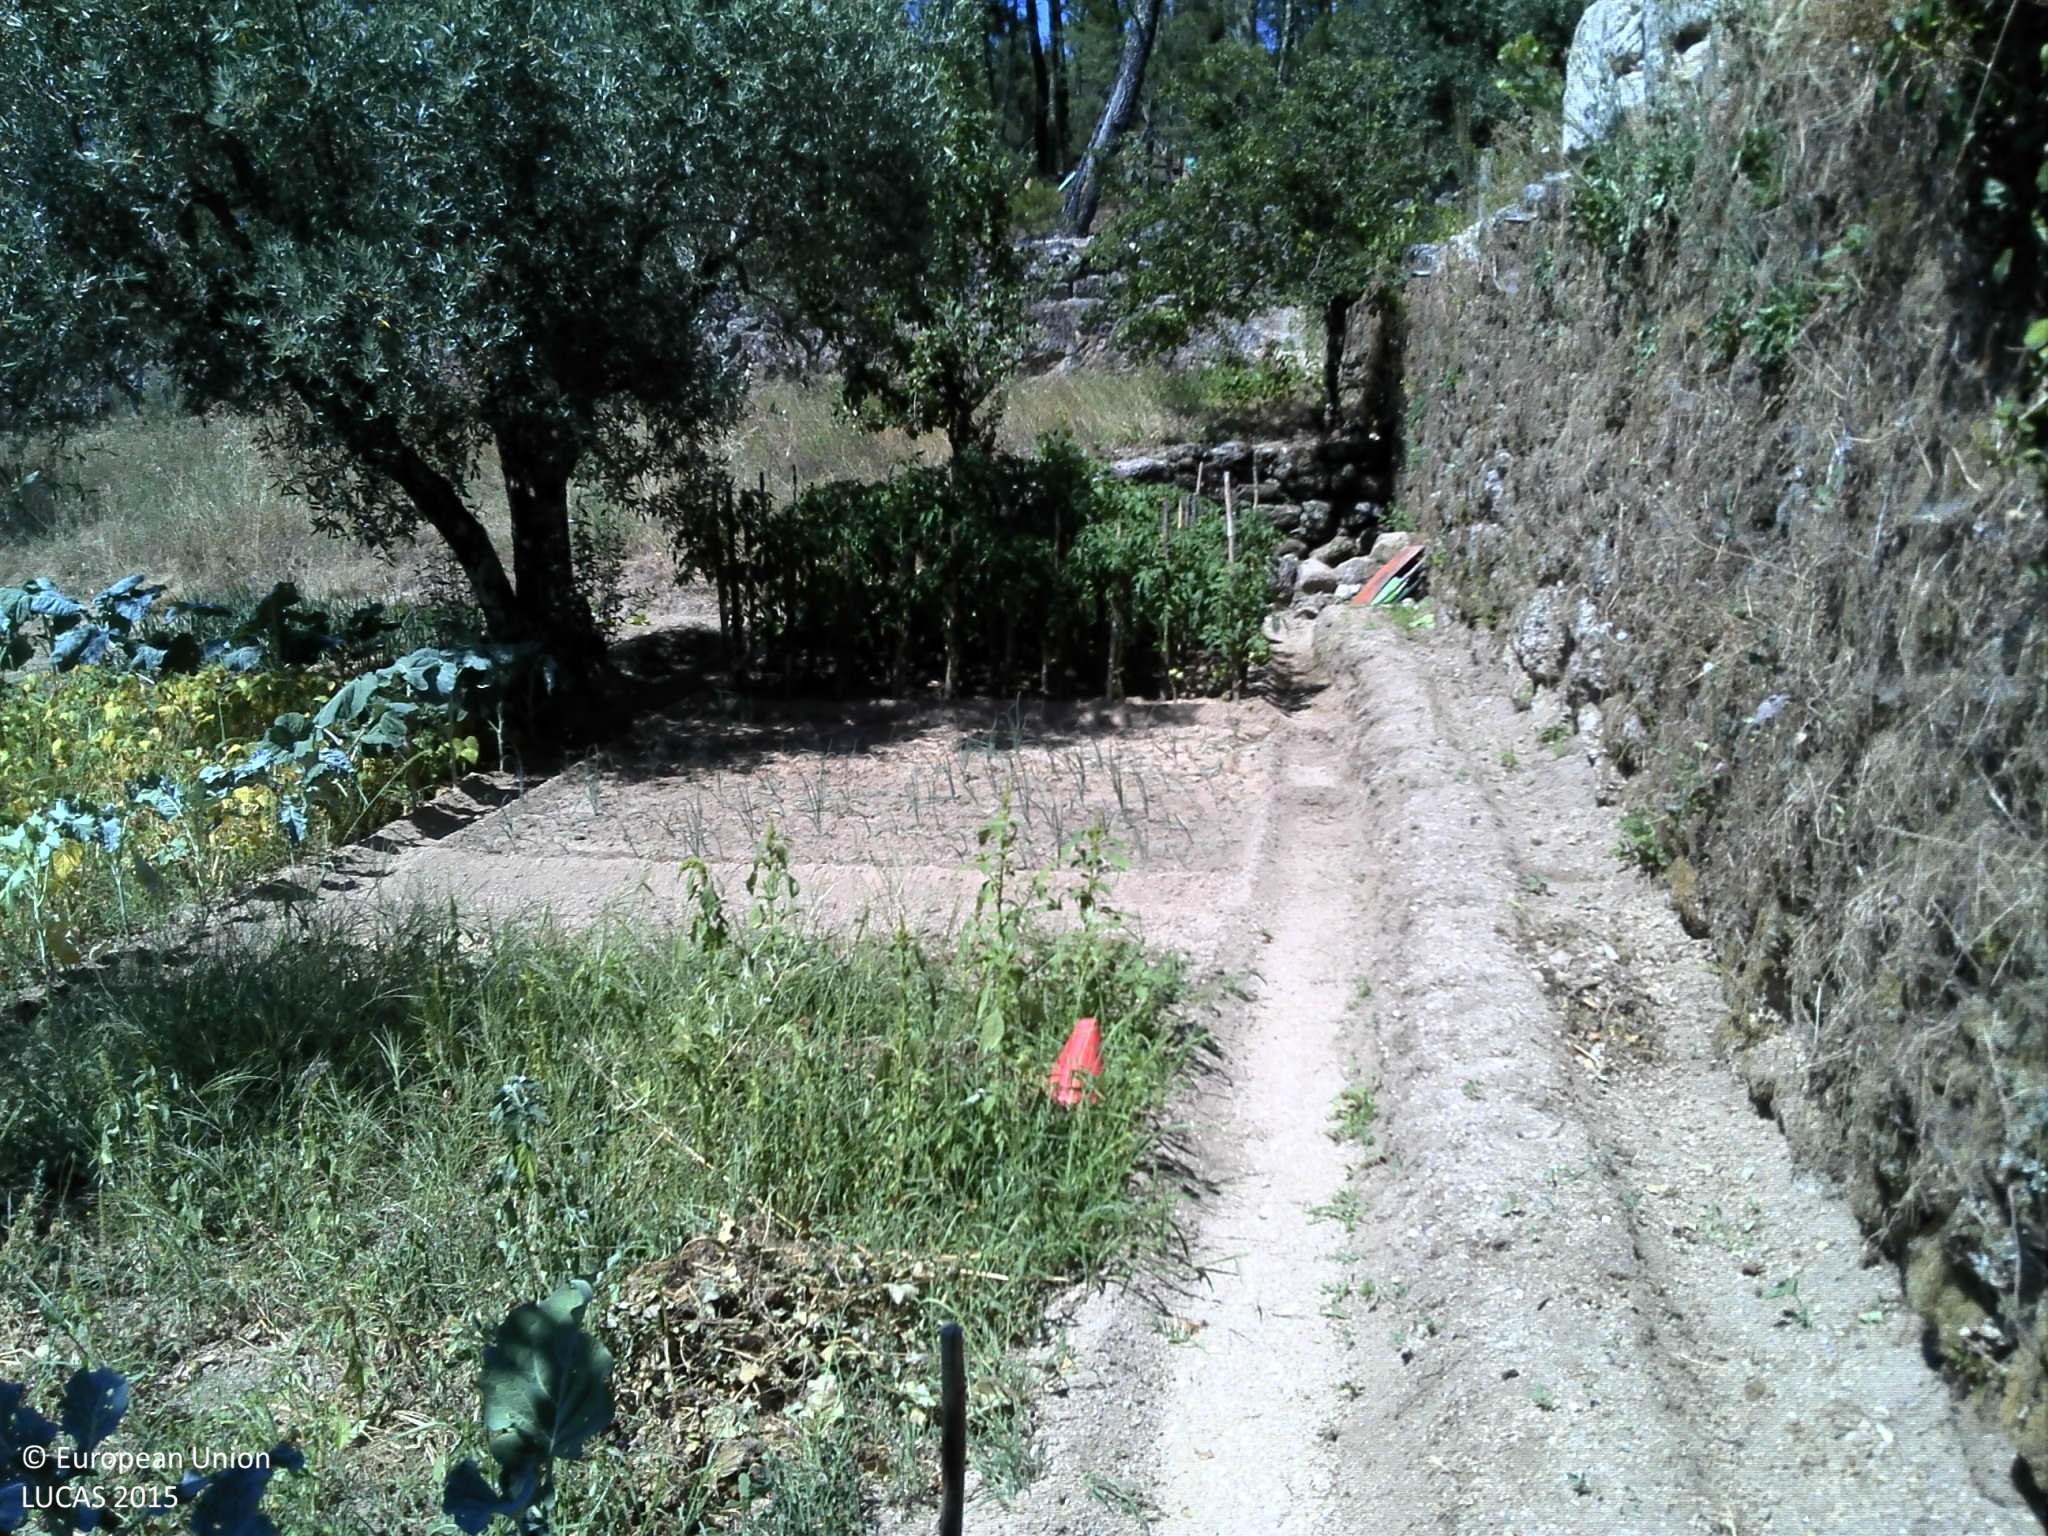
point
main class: Cropland
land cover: Olive groves
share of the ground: 10 - 25 %
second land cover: Other fresh vegetables
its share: 25 - 50 %
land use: Agriculture (excluding fallow land and kitchen gardens)
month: July
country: PT
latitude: 40.7369
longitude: -7.5590
